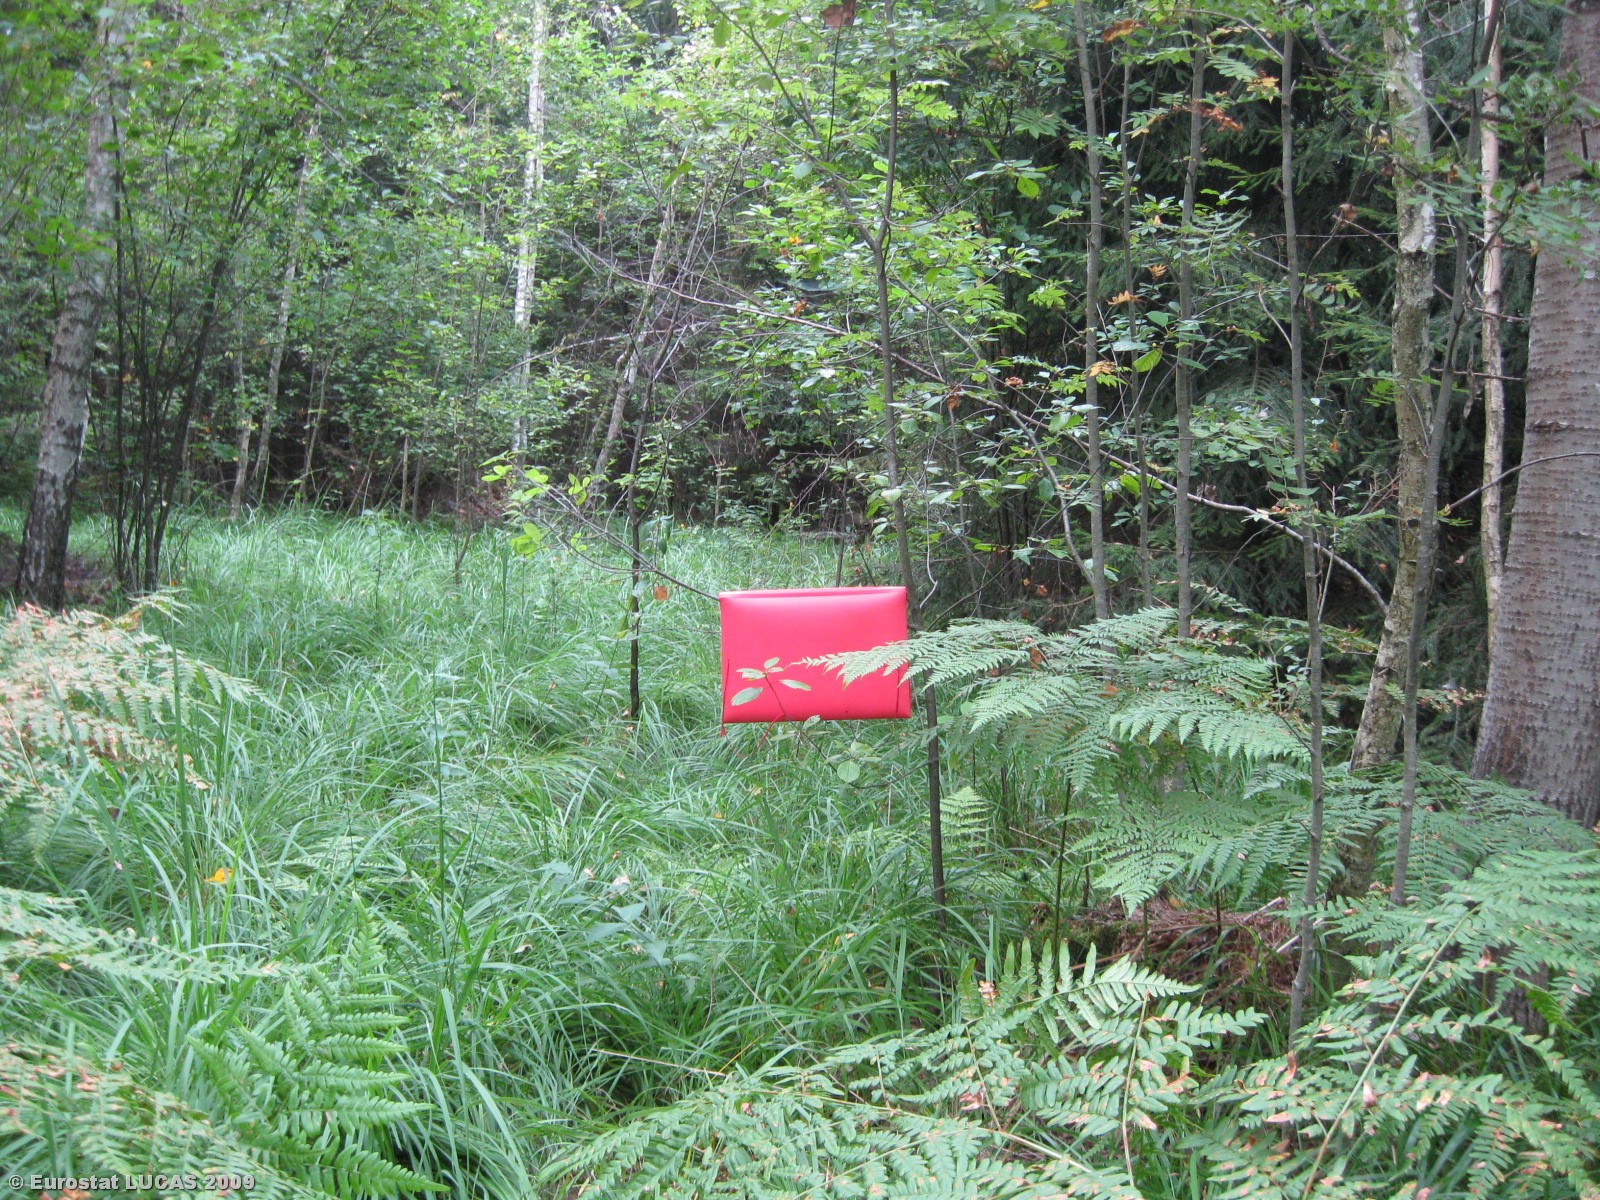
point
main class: Woodland
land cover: Mixed woodland
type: hemiboreal forest and nemoral coniferous forest and mixed broadleaved-coniferous forest
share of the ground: > 75 %
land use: Forestry
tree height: > 5 m
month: August
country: LT
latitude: 55.0915
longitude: 22.5830
